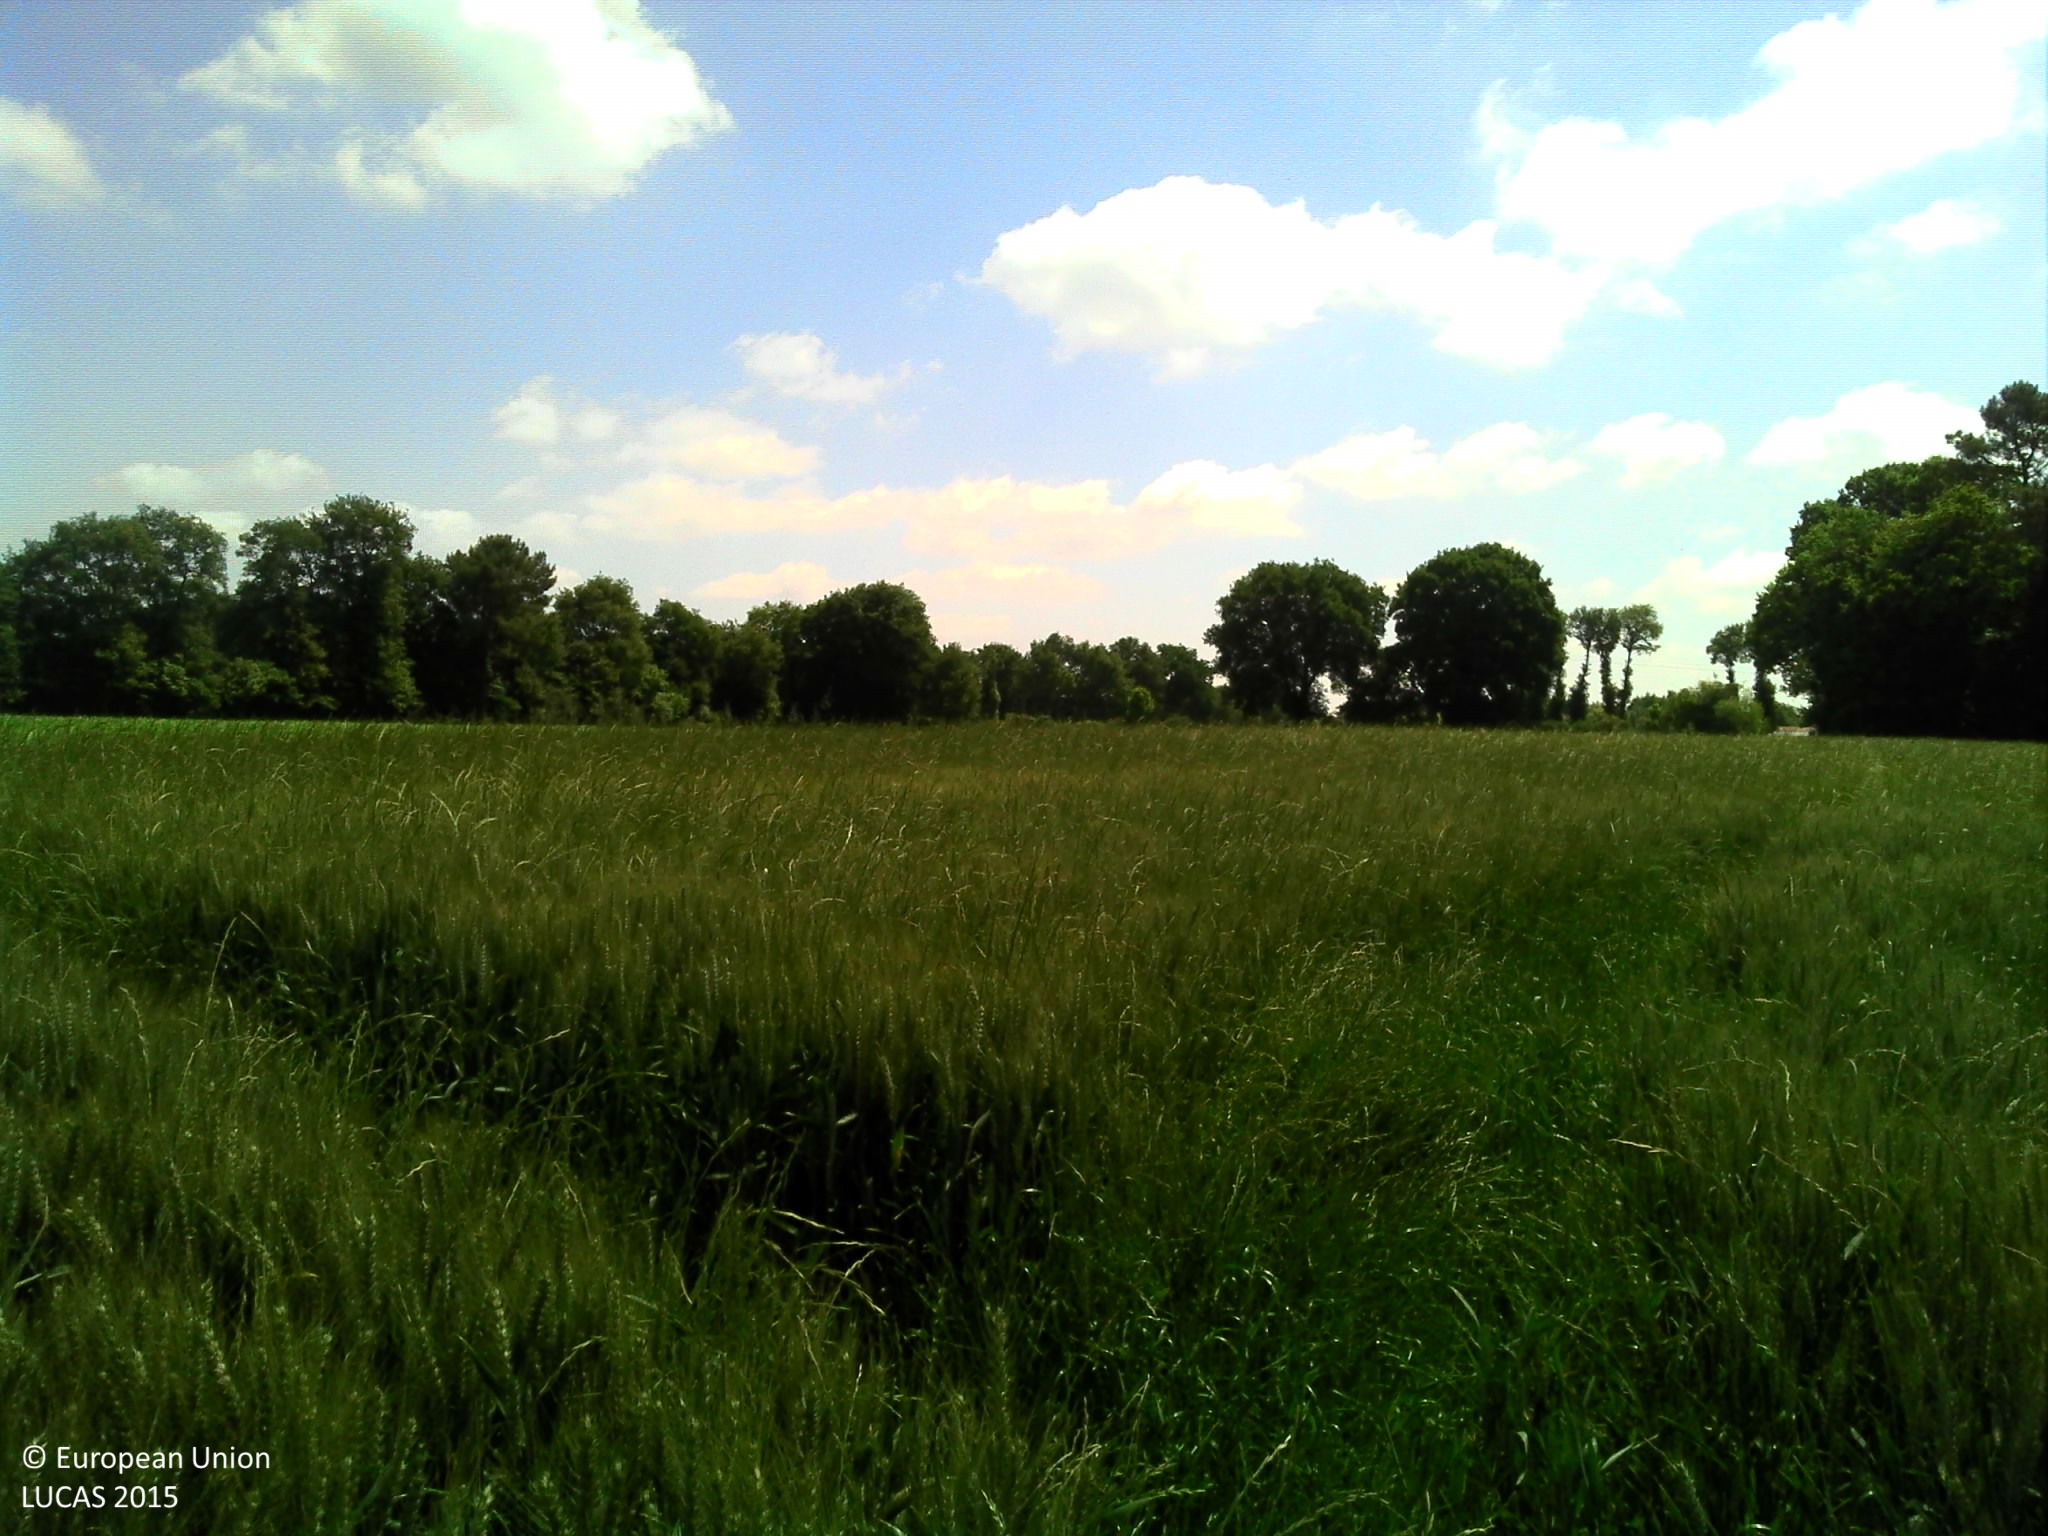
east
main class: Cropland
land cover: Common wheat
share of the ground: > 75 %
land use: Agriculture (excluding fallow land and kitchen gardens)
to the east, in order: Common wheat; Maize; Abandoned hedges; Fences; Grassland without tree/shrub cover
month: June
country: FR
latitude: 47.9964
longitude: -1.8840
